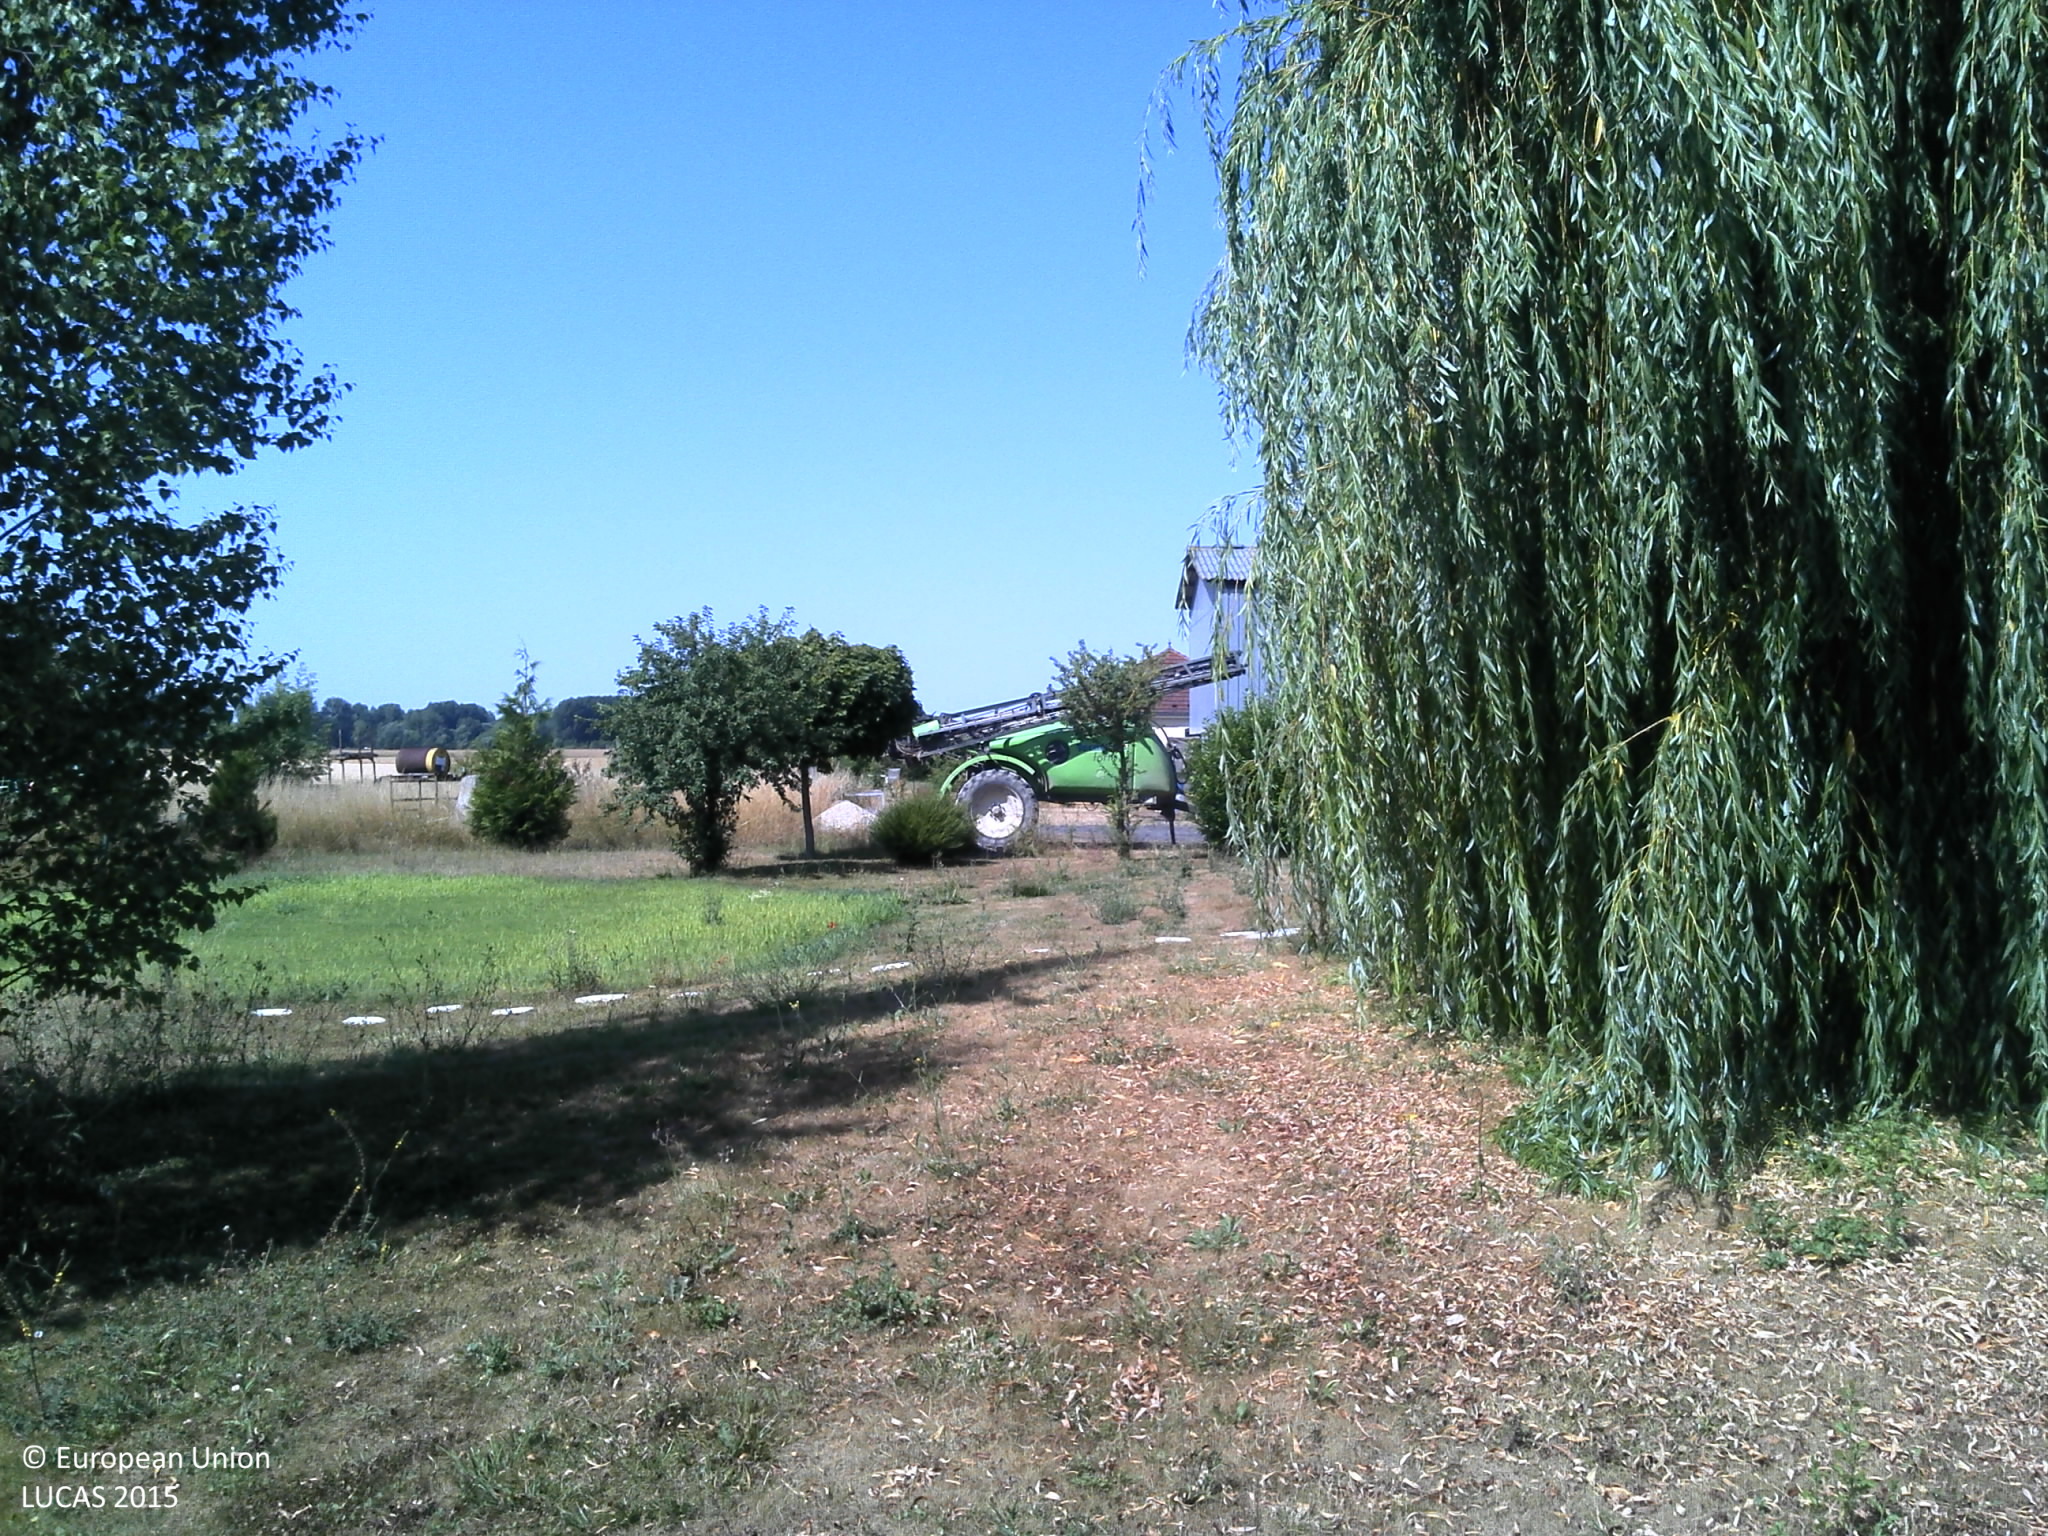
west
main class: Grassland
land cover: Grassland with sparse tree/shrub cover
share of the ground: > 75 %
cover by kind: herbaceous plants 95 %, broadleaved forest trees 5 %
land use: Residential
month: July
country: FR
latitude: 49.4532
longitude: 4.0770
